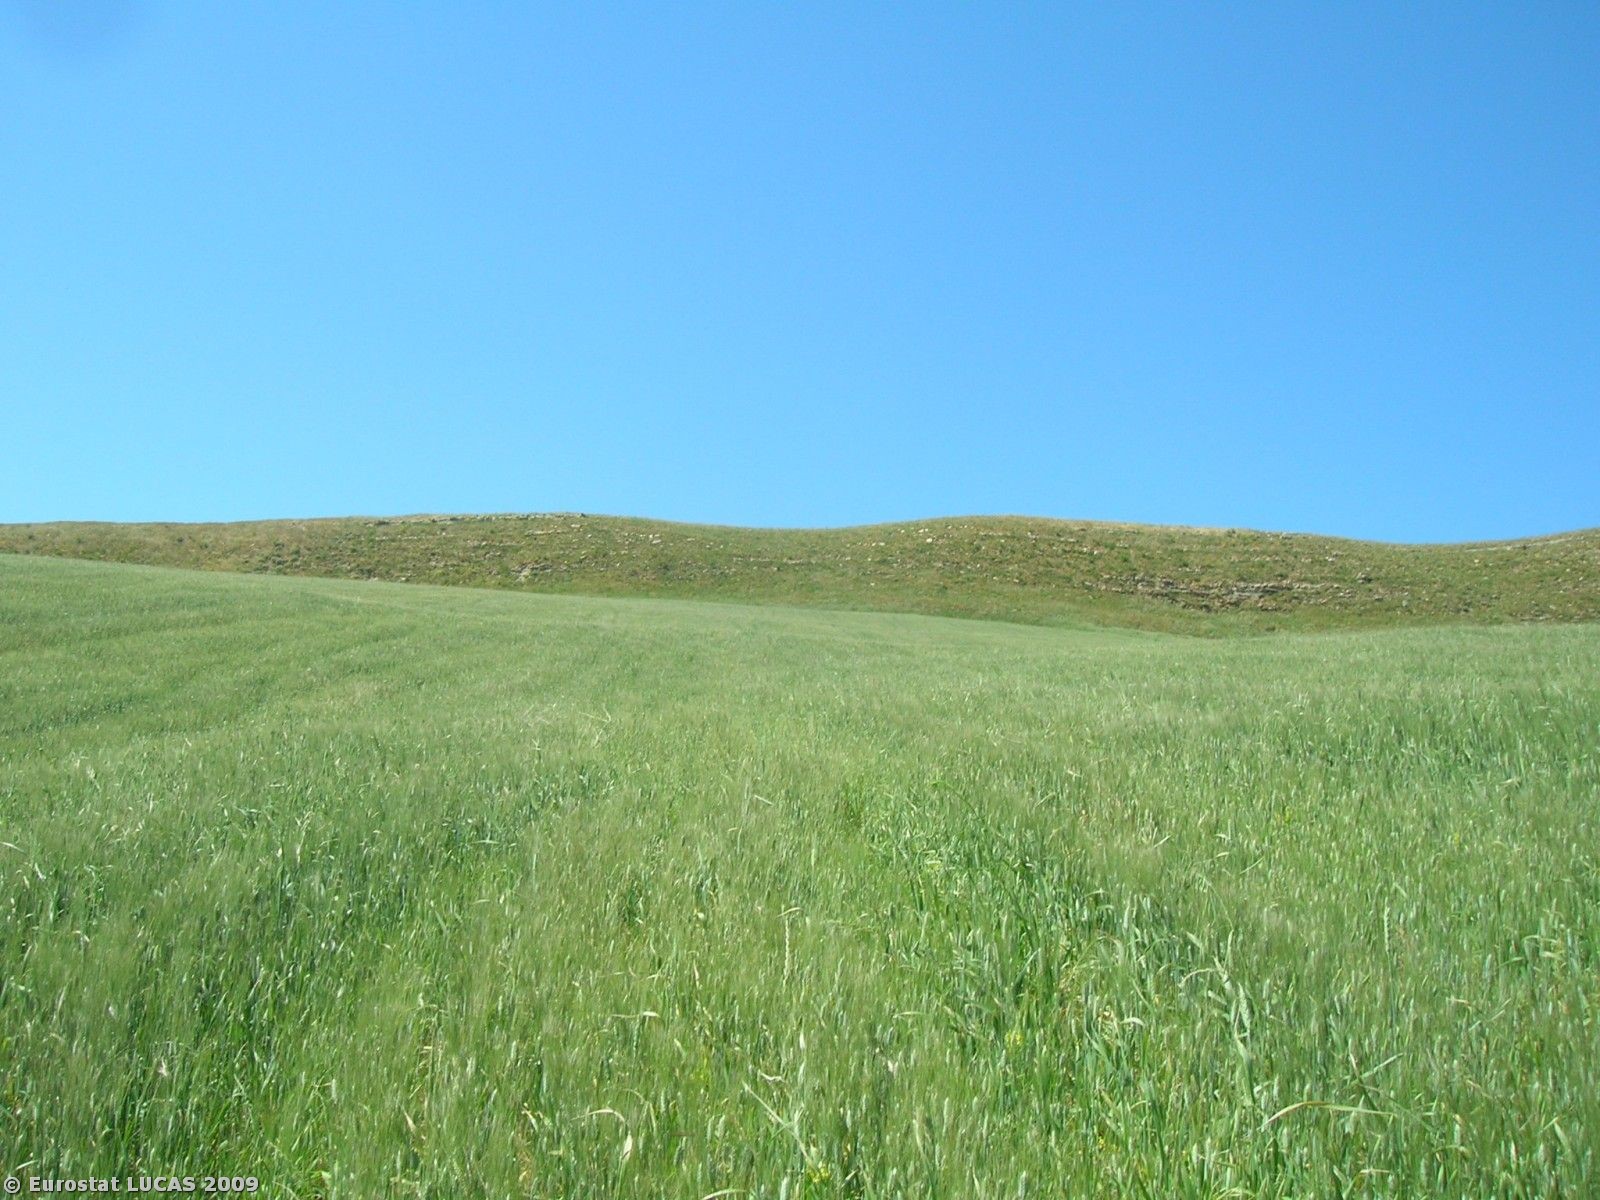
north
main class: Cropland
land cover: Durum wheat
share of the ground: > 75 %
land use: Agriculture (excluding fallow land and kitchen gardens)
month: May
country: IT
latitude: 37.6964
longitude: 13.1182
